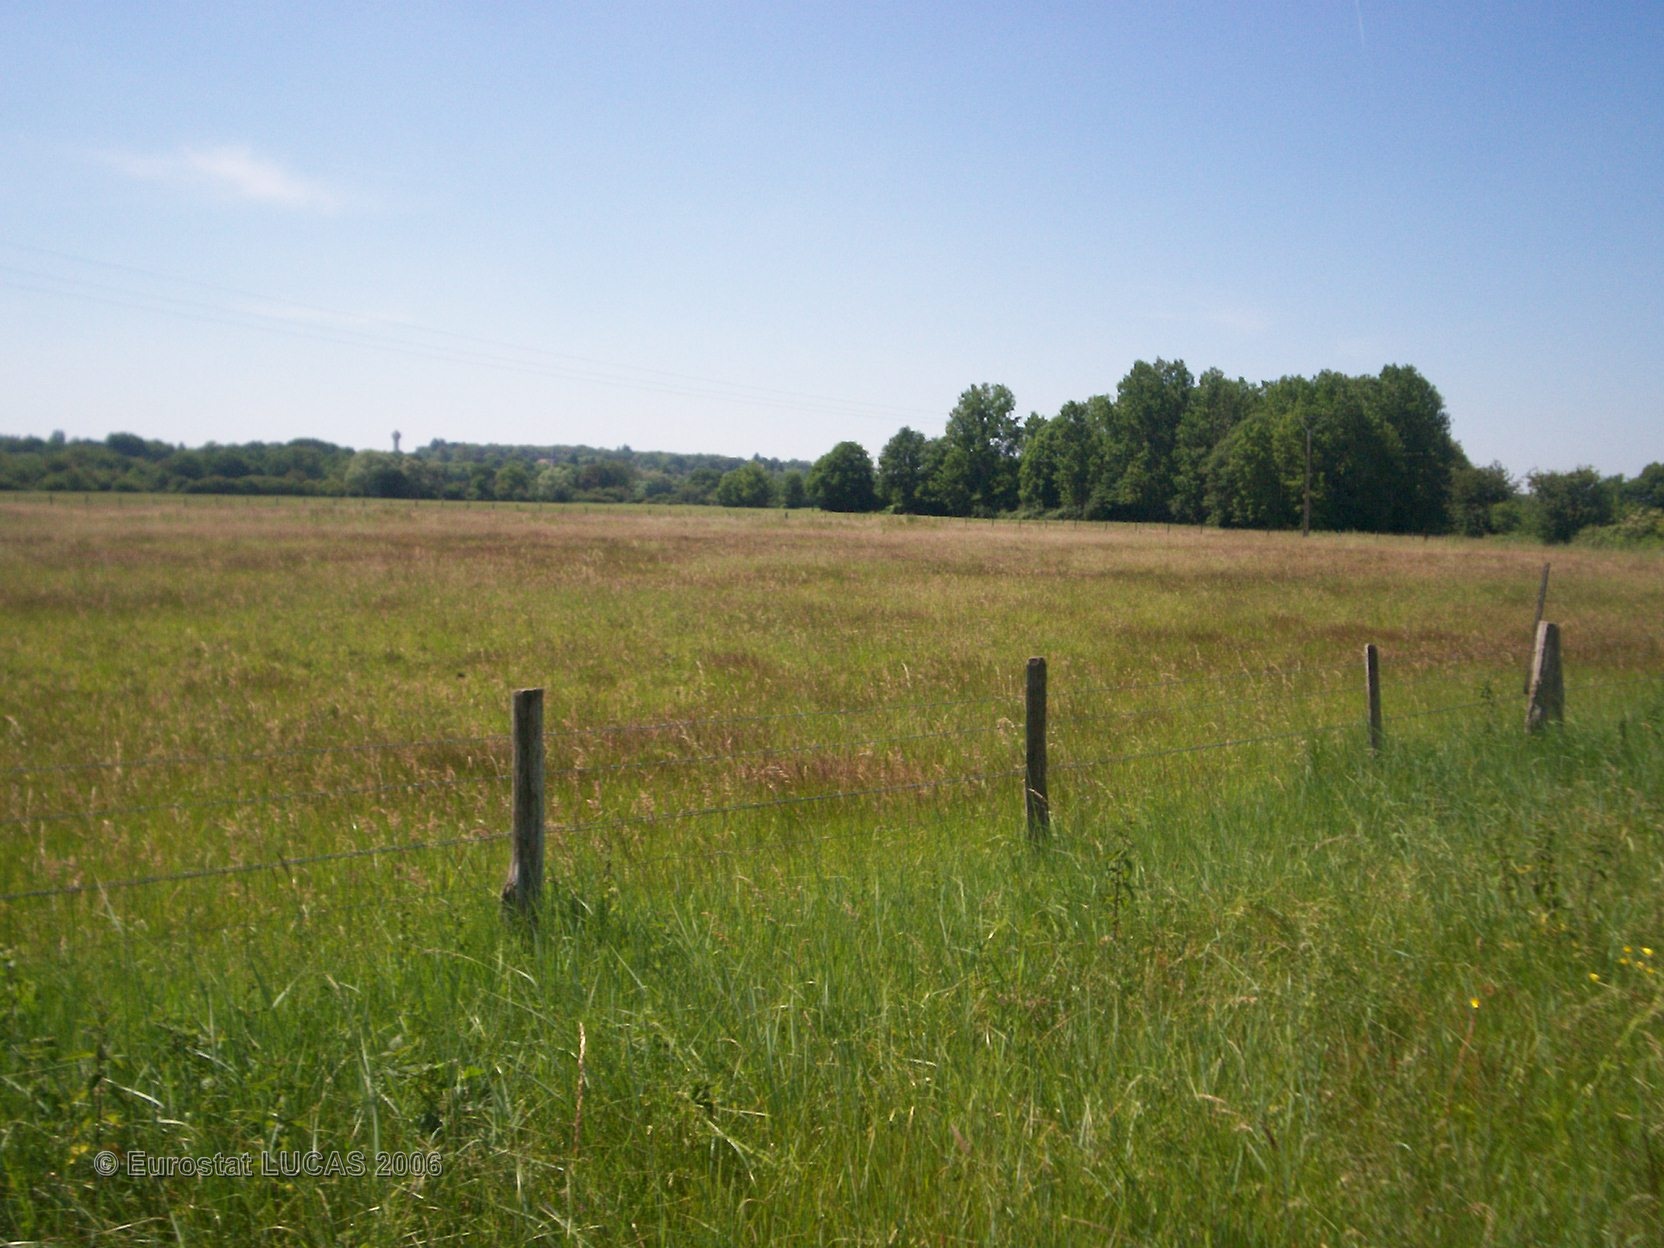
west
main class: Grassland
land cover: Grassland without tree/shrub cover
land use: Agriculture (excluding fallow land and kitchen gardens)
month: June
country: FR
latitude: 46.9577
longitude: 3.0709
